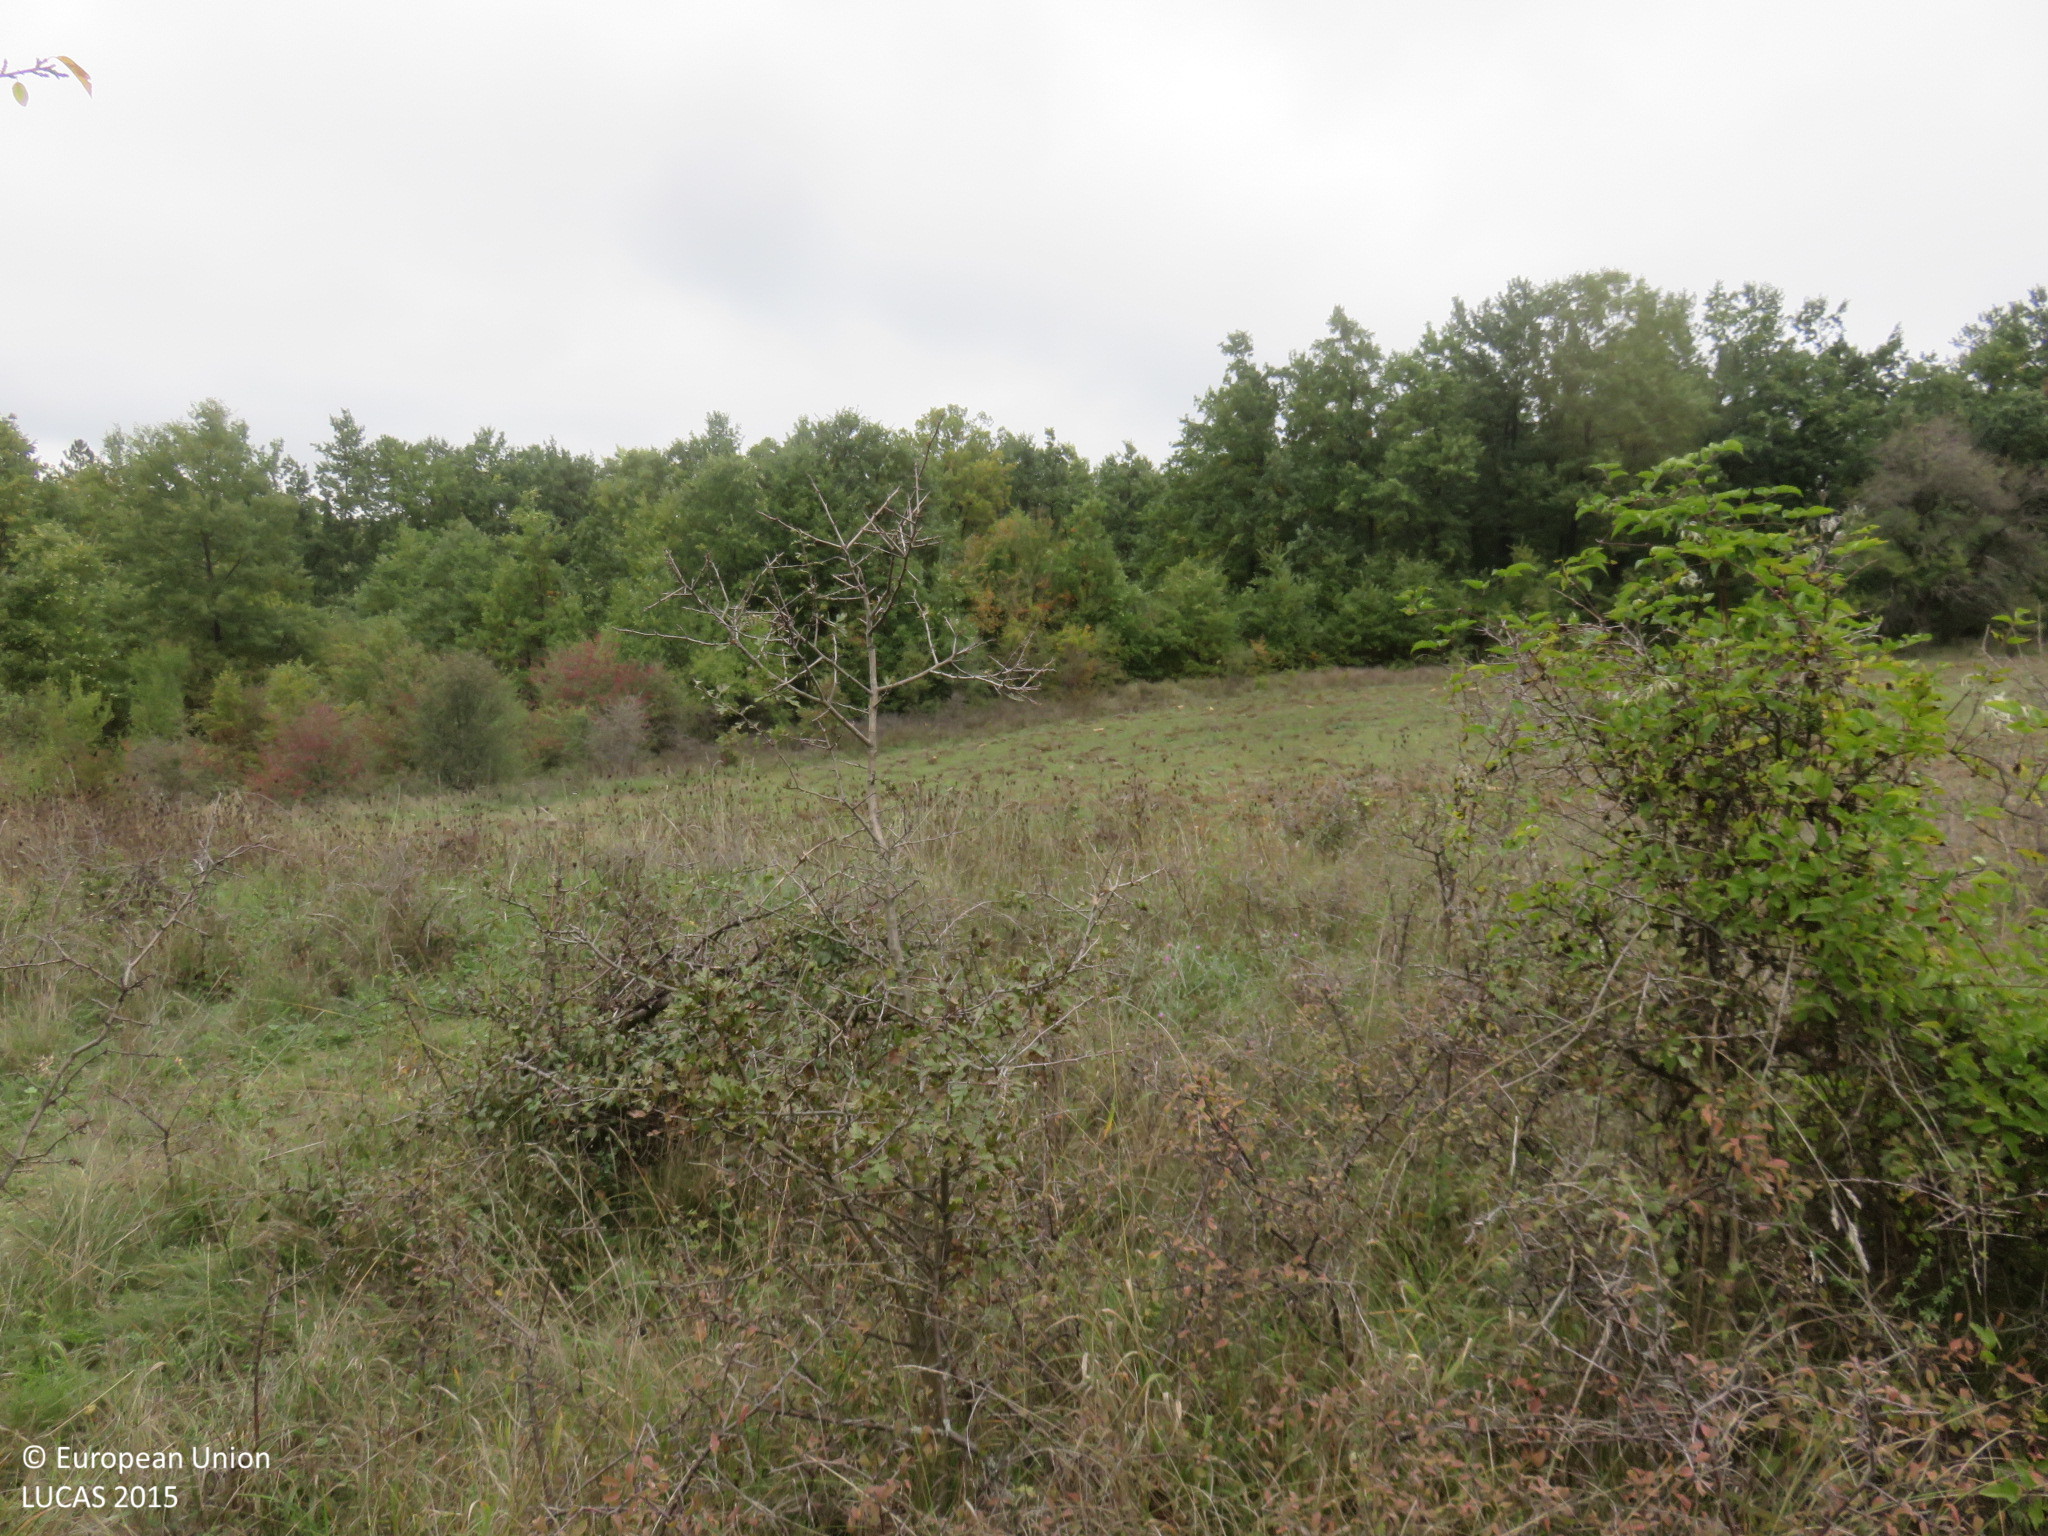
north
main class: Shrubland
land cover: Shrubland with sparse tree cover
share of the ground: > 75 %
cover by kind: shrubs 95 %, broadleaved forest trees 5 %
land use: Semi-natural and natural areas not in use
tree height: < 5 m
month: October
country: BG
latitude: 43.0140
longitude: 25.2483
